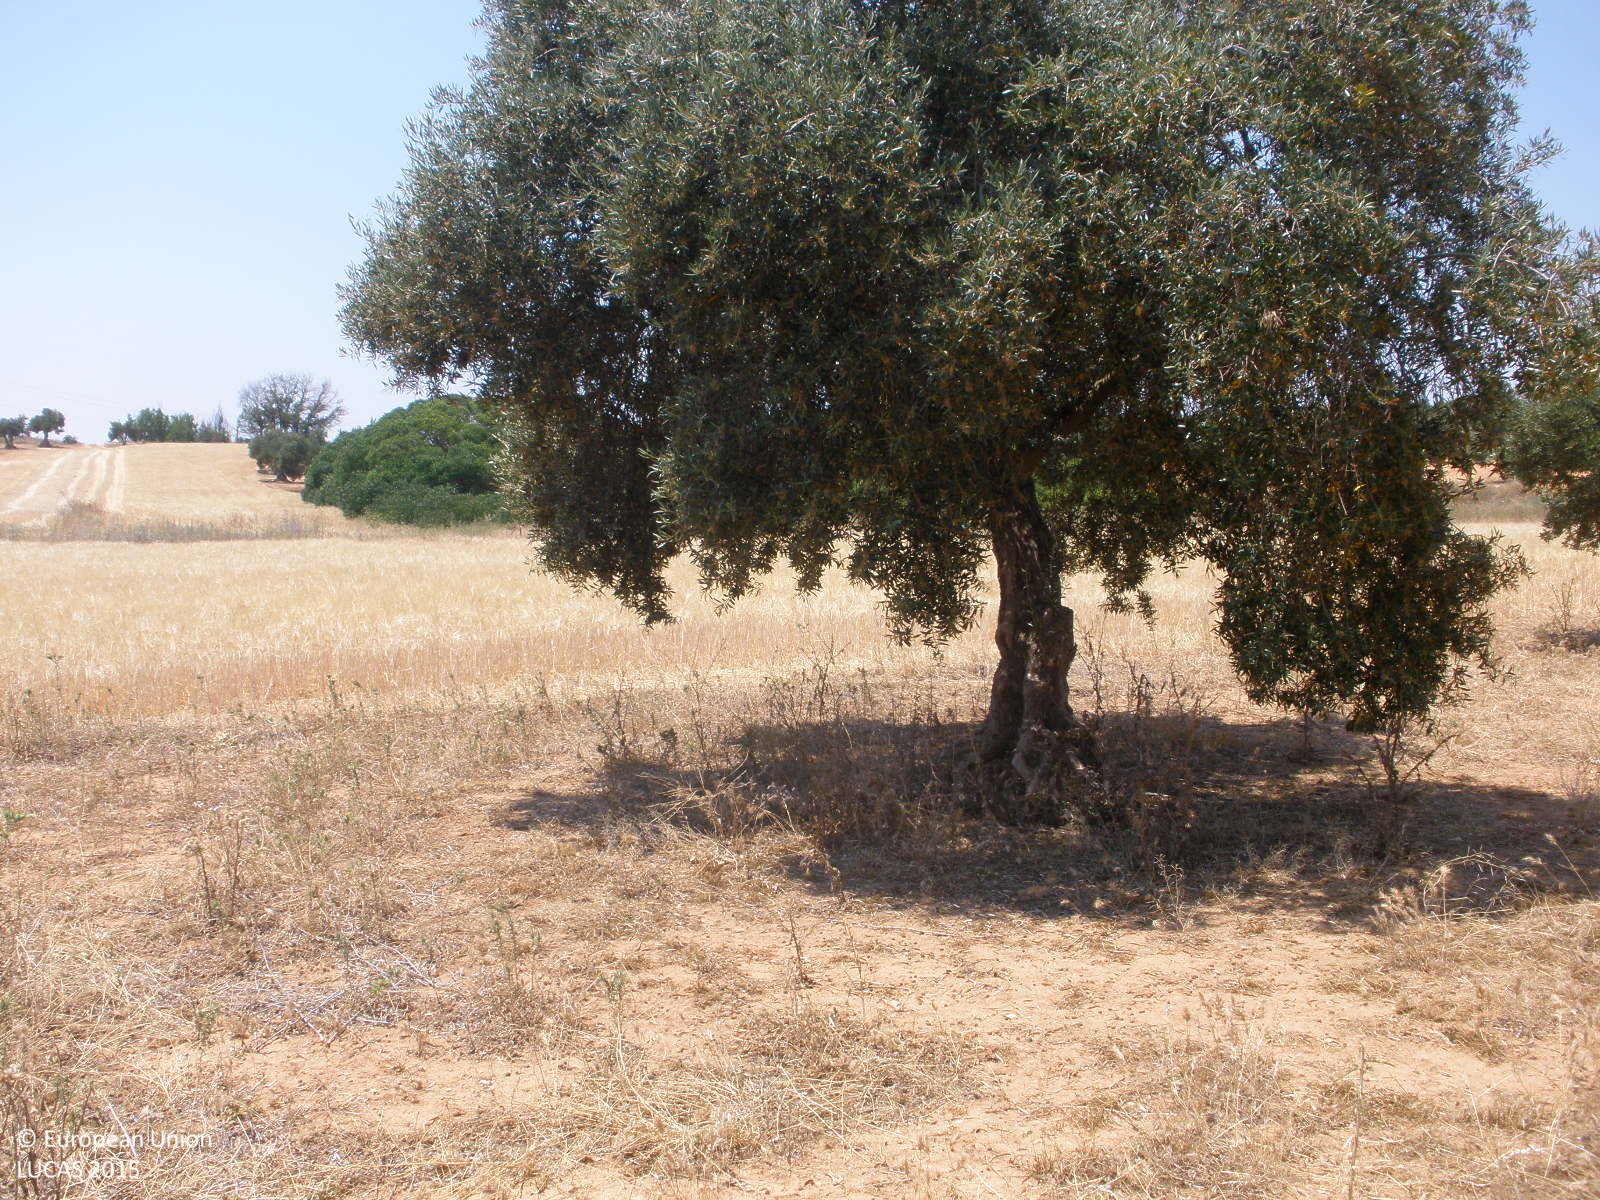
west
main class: Cropland
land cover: Olive groves
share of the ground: 25 - 50 %
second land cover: Grassland without tree/shrub cover
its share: 50 - 75 %
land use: Agriculture (excluding fallow land and kitchen gardens)
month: June
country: ES
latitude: 40.1953
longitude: -3.1965
